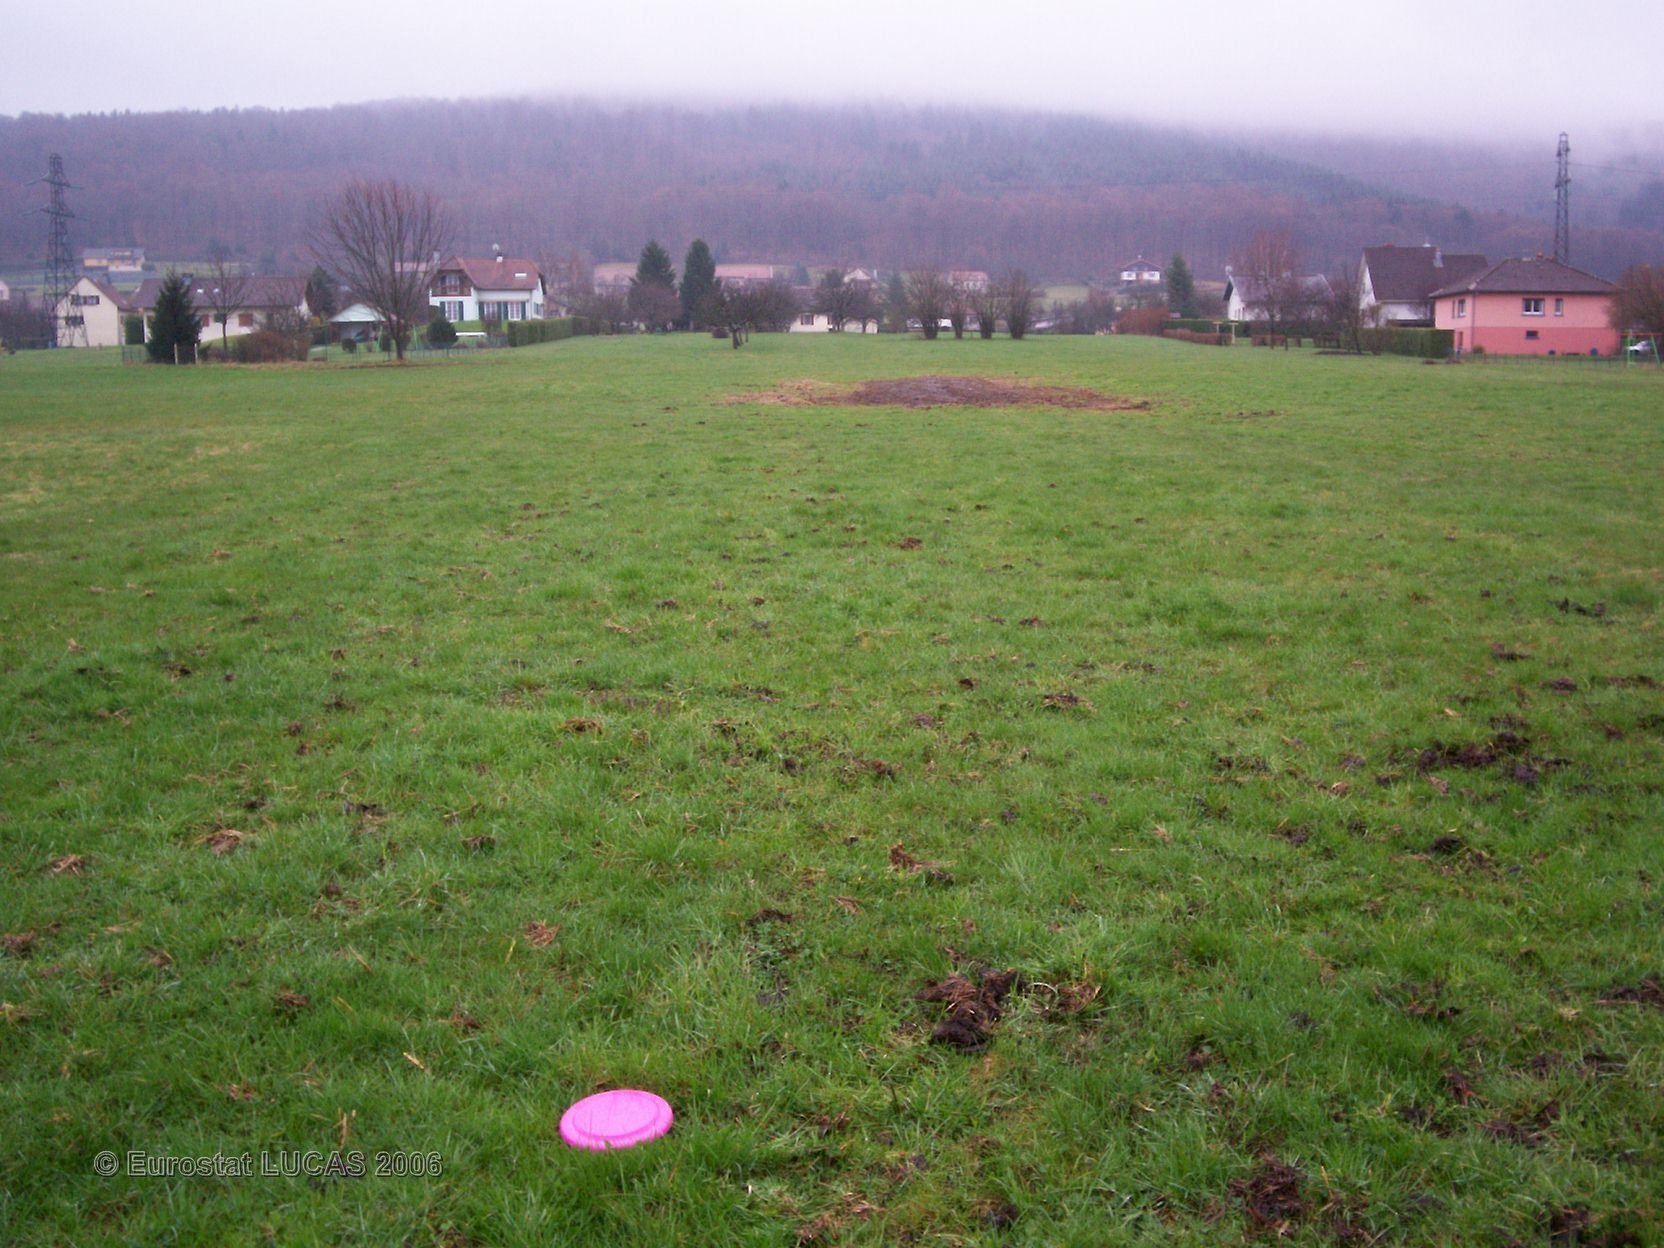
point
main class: Grassland
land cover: Grassland without tree/shrub cover
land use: Agriculture (excluding fallow land and kitchen gardens)
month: April
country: FR
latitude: 47.6734
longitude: 6.8183
